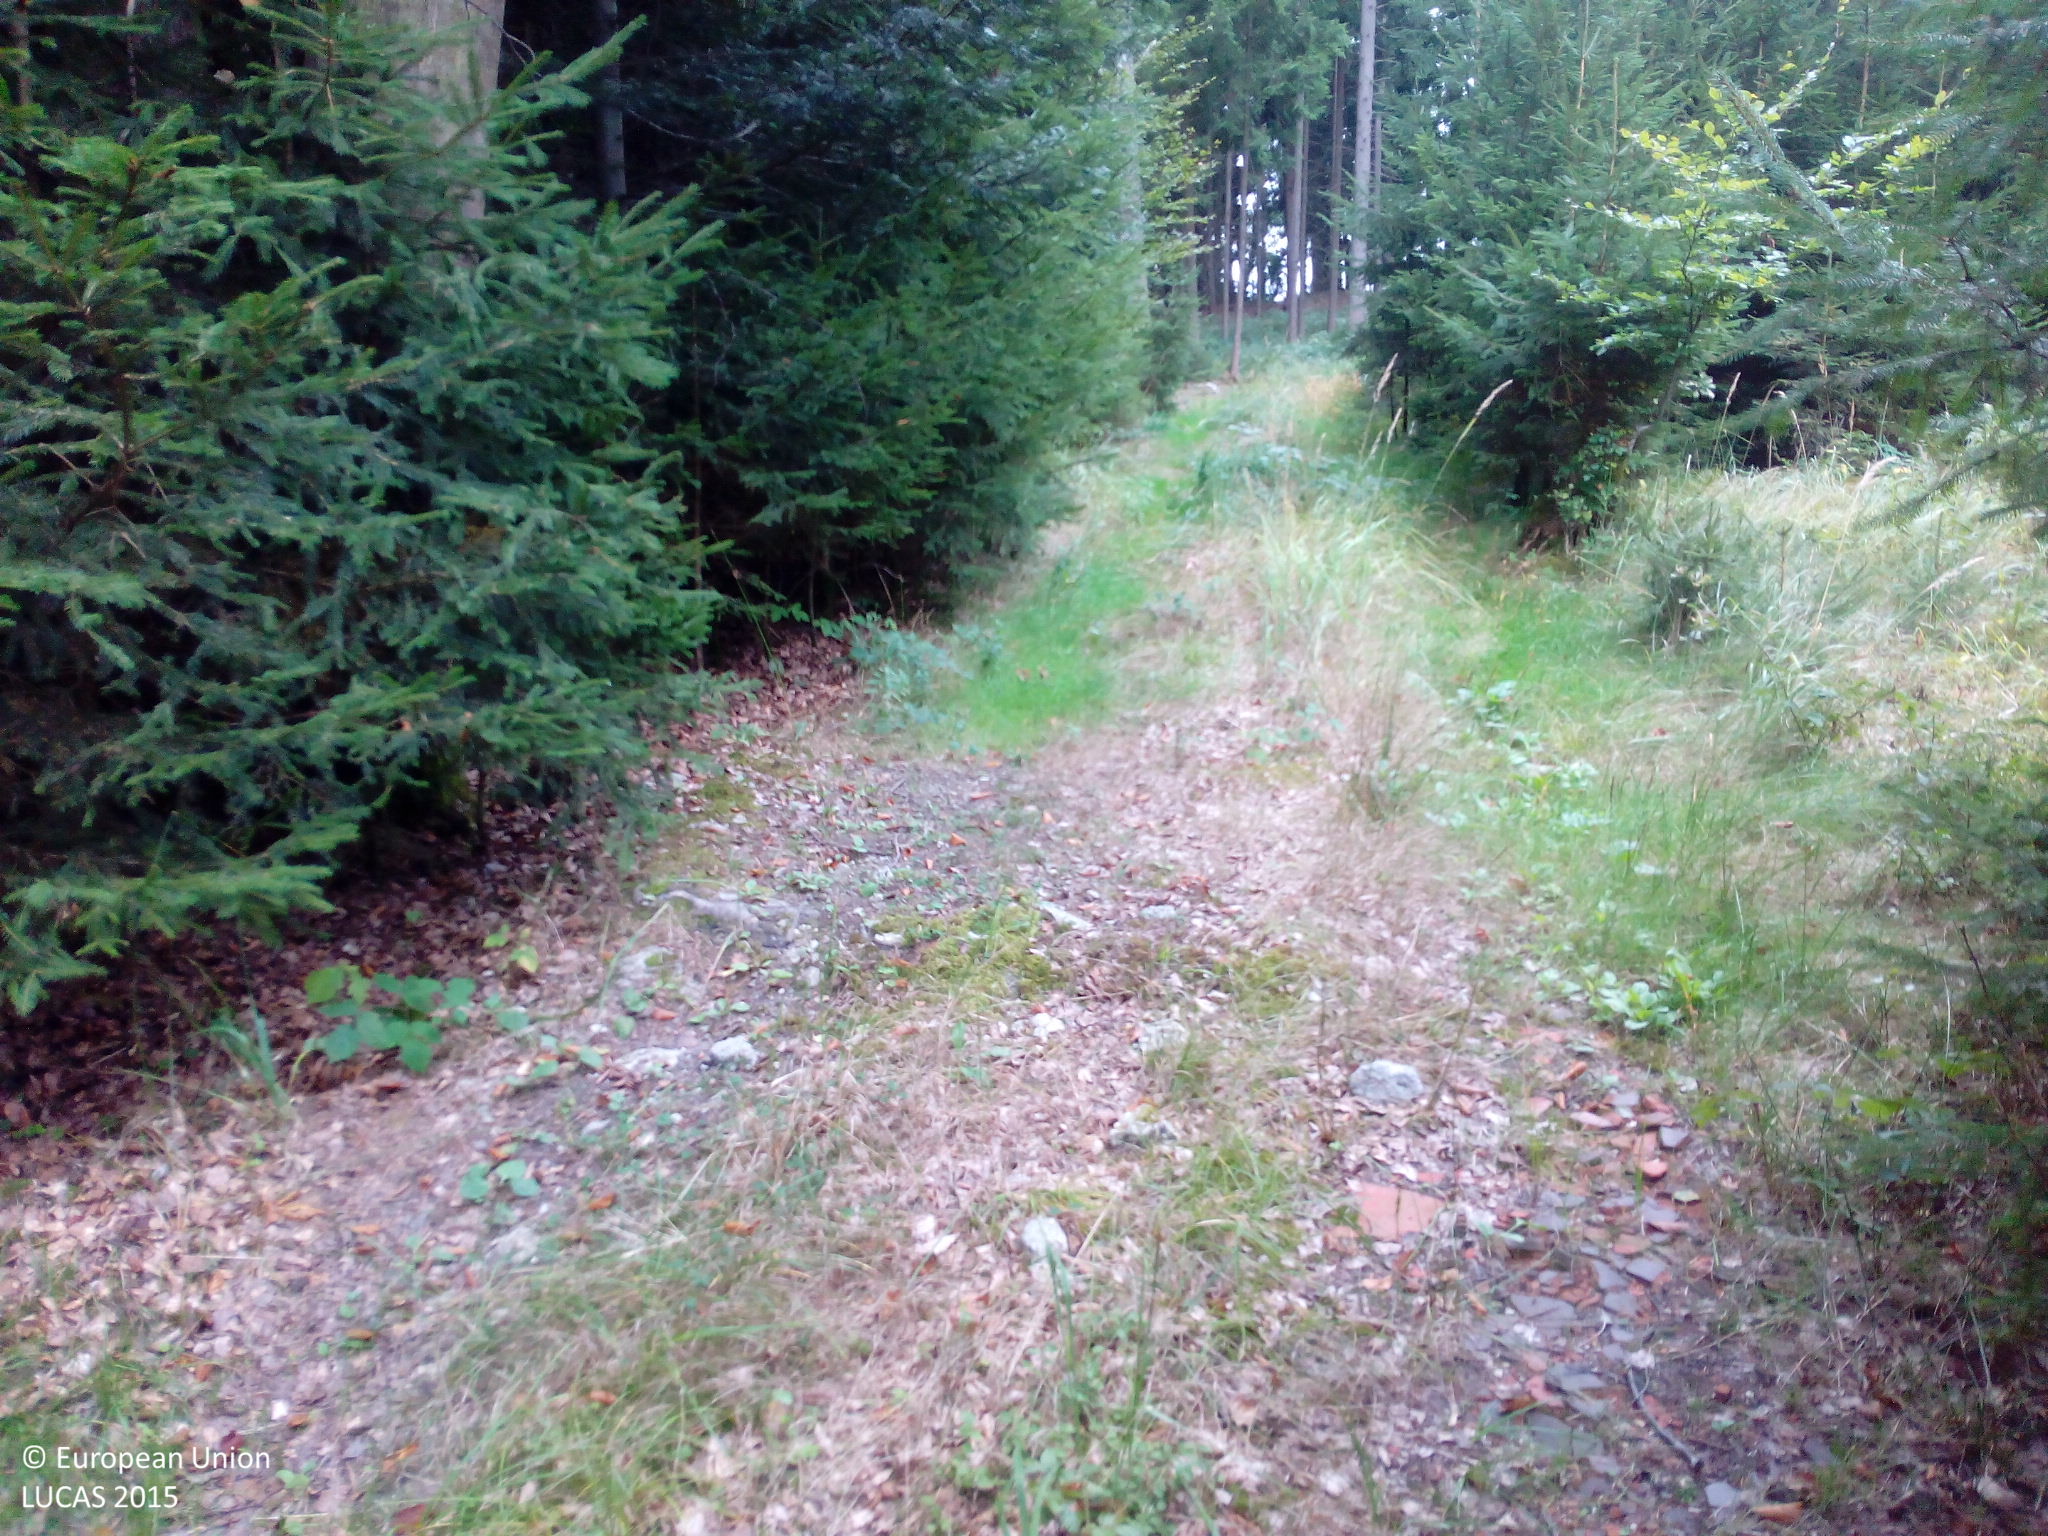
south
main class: Woodland
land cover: Spruce dominated coniferous woodland
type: hemiboreal forest and nemoral coniferous forest and mixed broadleaved-coniferous forest
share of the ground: > 75 %
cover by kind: coniferous forest trees 100 %
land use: Forestry
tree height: > 5 m
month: September
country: DE
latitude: 48.4836
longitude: 11.4740
